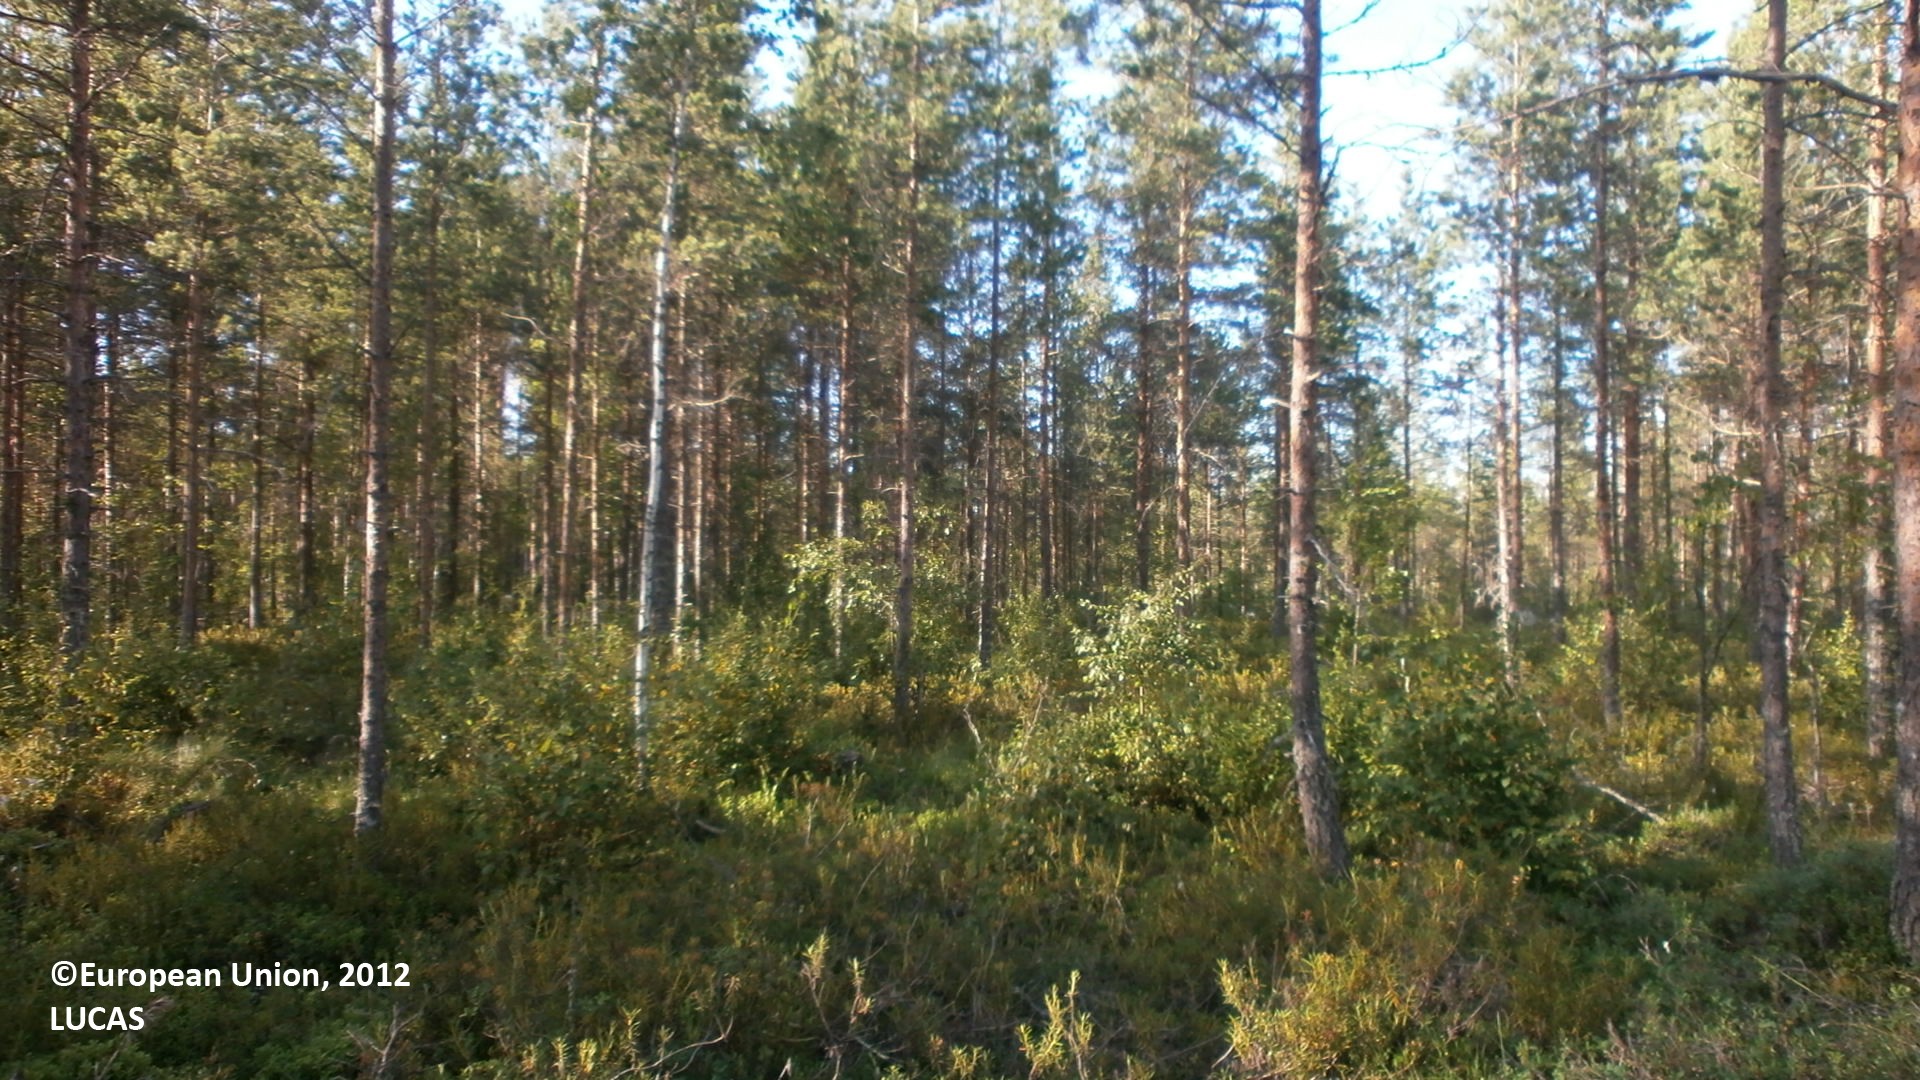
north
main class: Woodland
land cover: Pine dominated coniferous woodland
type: mire and swamp forests
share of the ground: 50 - 75 %
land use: Forestry
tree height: > 5 m
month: July
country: FI
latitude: 64.0971
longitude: 24.2879
